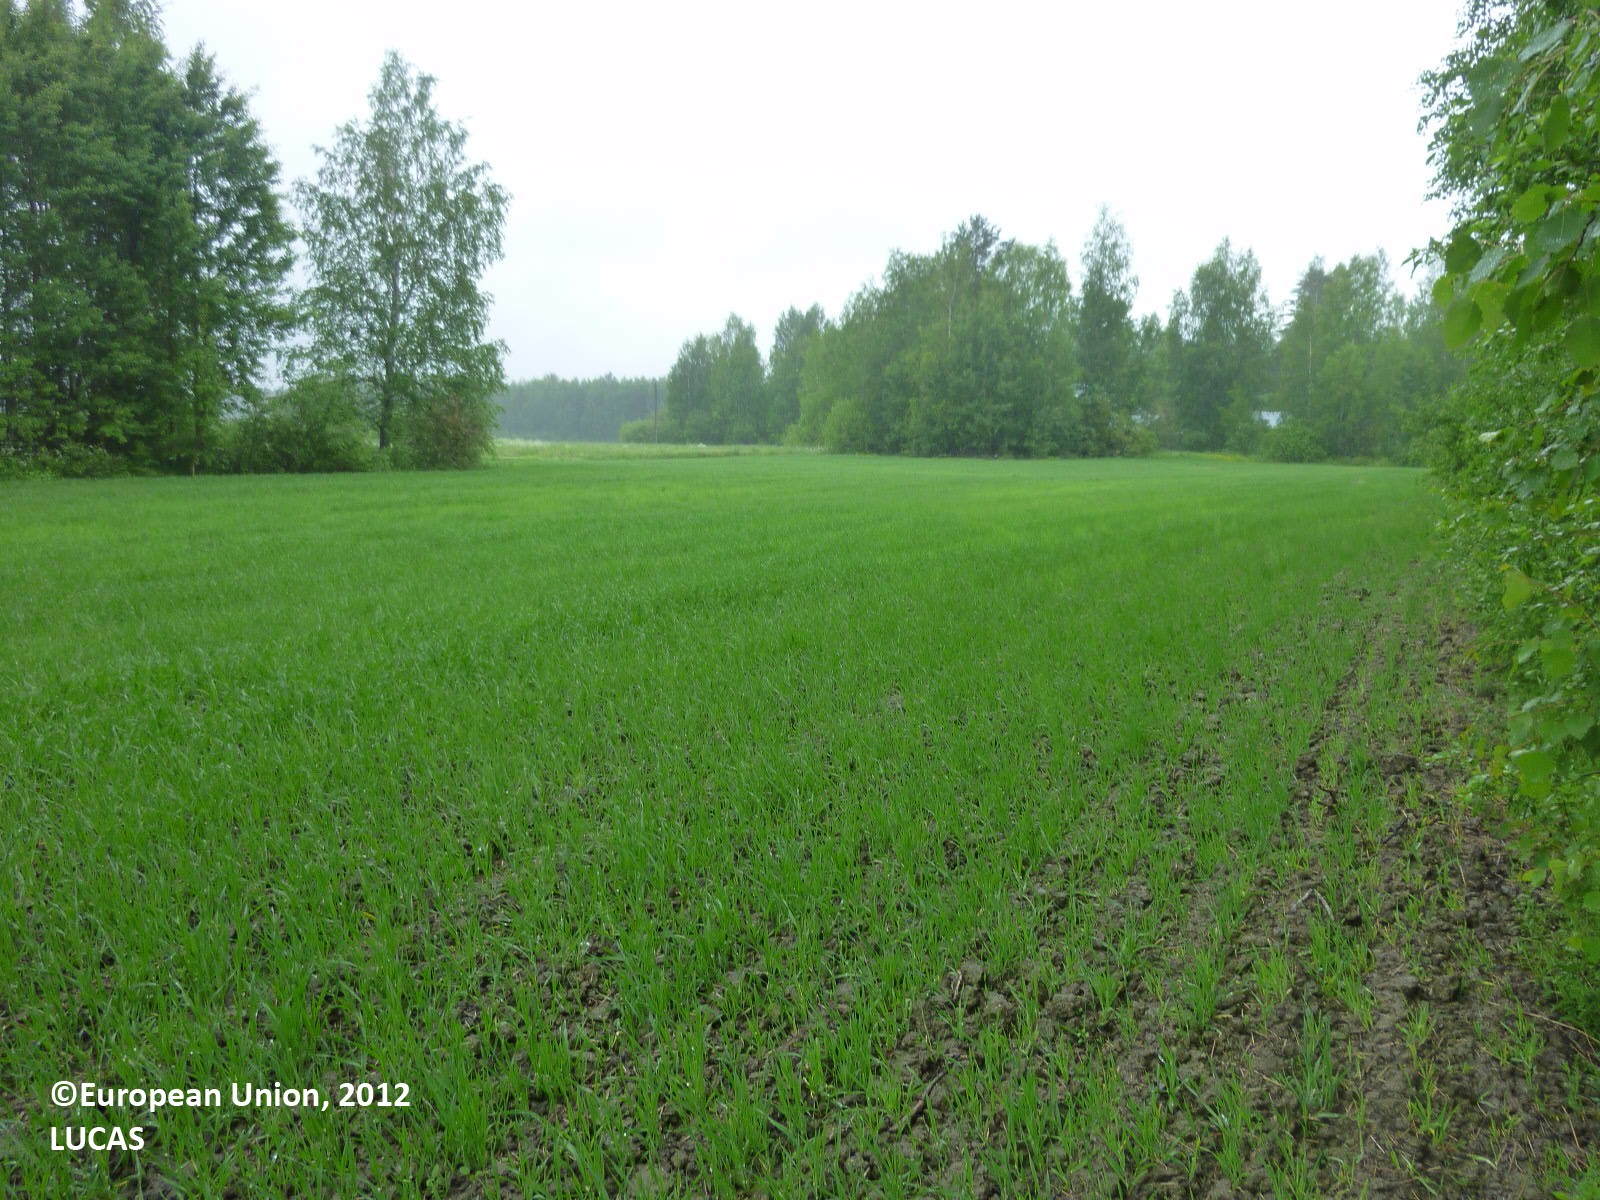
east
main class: Cropland
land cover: Barley
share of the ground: > 75 %
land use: Agriculture (excluding fallow land and kitchen gardens)
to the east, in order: Barley; Grass margins; Ditches and canals; Pine dominated mixed woodland; Grass margins; Ditches and canals; Grass margins; Barley; Grass margins; Ditches and canals; Grass margins; Pine dominated mixed woodland; Grass margins; Paved roads, cycling and walking lanes; Grass margins; Pine dominated mixed woodland; Grassland with sparse tree/shrub cover; Ditches and canals; Grass margins; Paved roads, cycling and walking lanes; Grass margins; Temporary grasslands; Ditches and canals; Arable land (only in case pi)
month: June
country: FI
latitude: 61.6094
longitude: 22.3335
